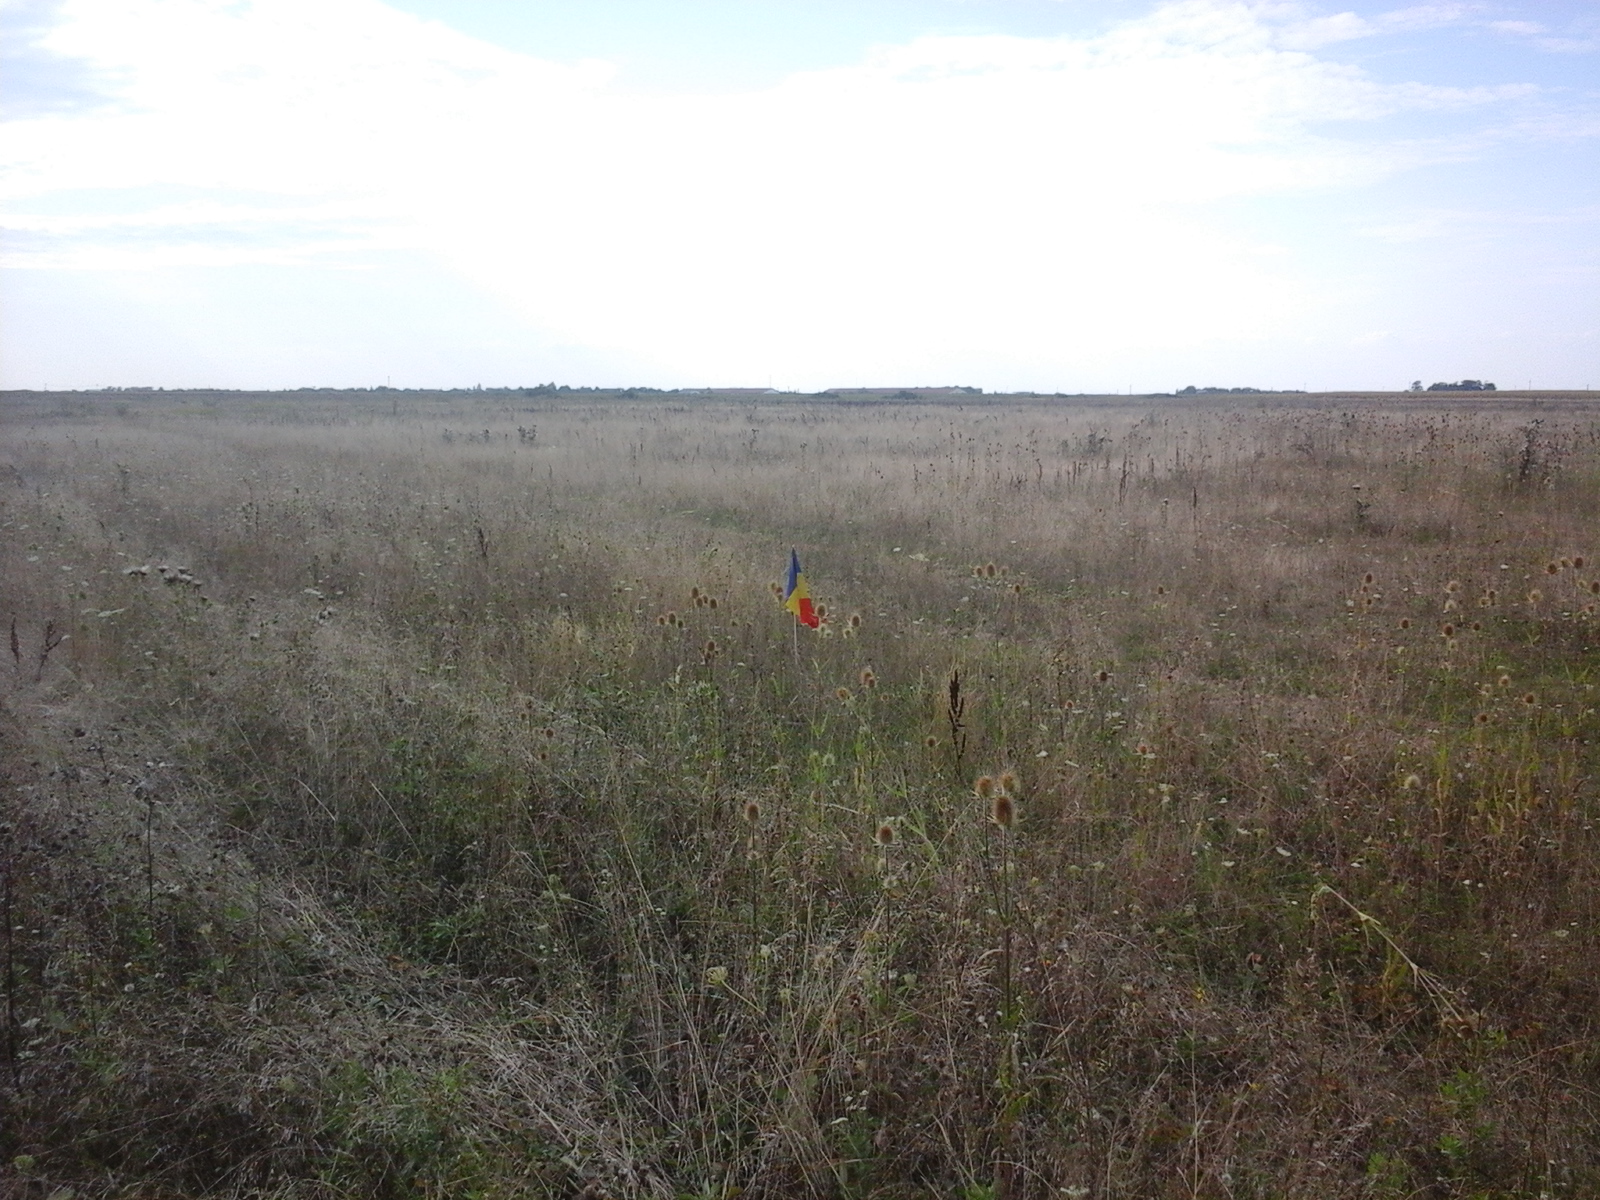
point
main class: Grassland
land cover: Spontaneously vegetated surfaces
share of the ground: > 75 %
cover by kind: herbaceous plants 100 %
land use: Fallow land
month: August
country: RO
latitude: 46.7160
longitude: 21.6181
